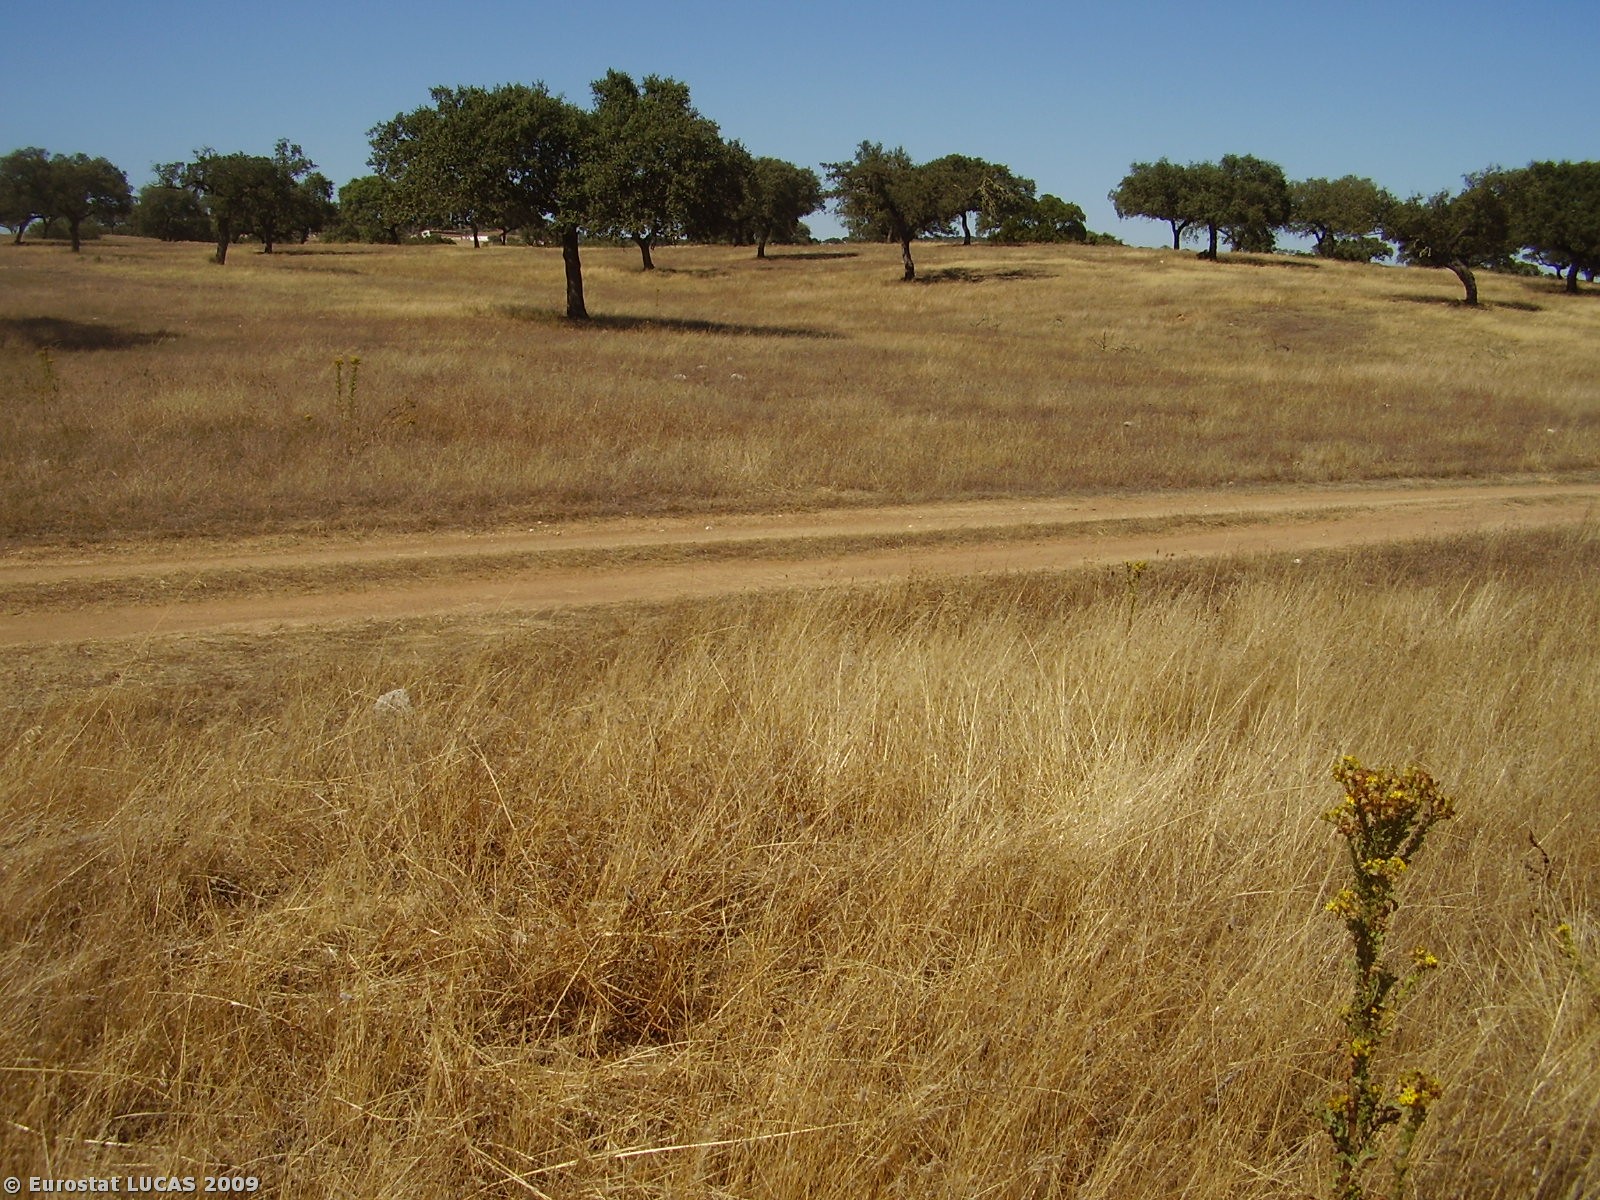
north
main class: Grassland
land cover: Grassland without tree/shrub cover
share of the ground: > 75 %
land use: Fallow land
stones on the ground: 25 - 50 %
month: July
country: PT
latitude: 37.8834
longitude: -7.5155
